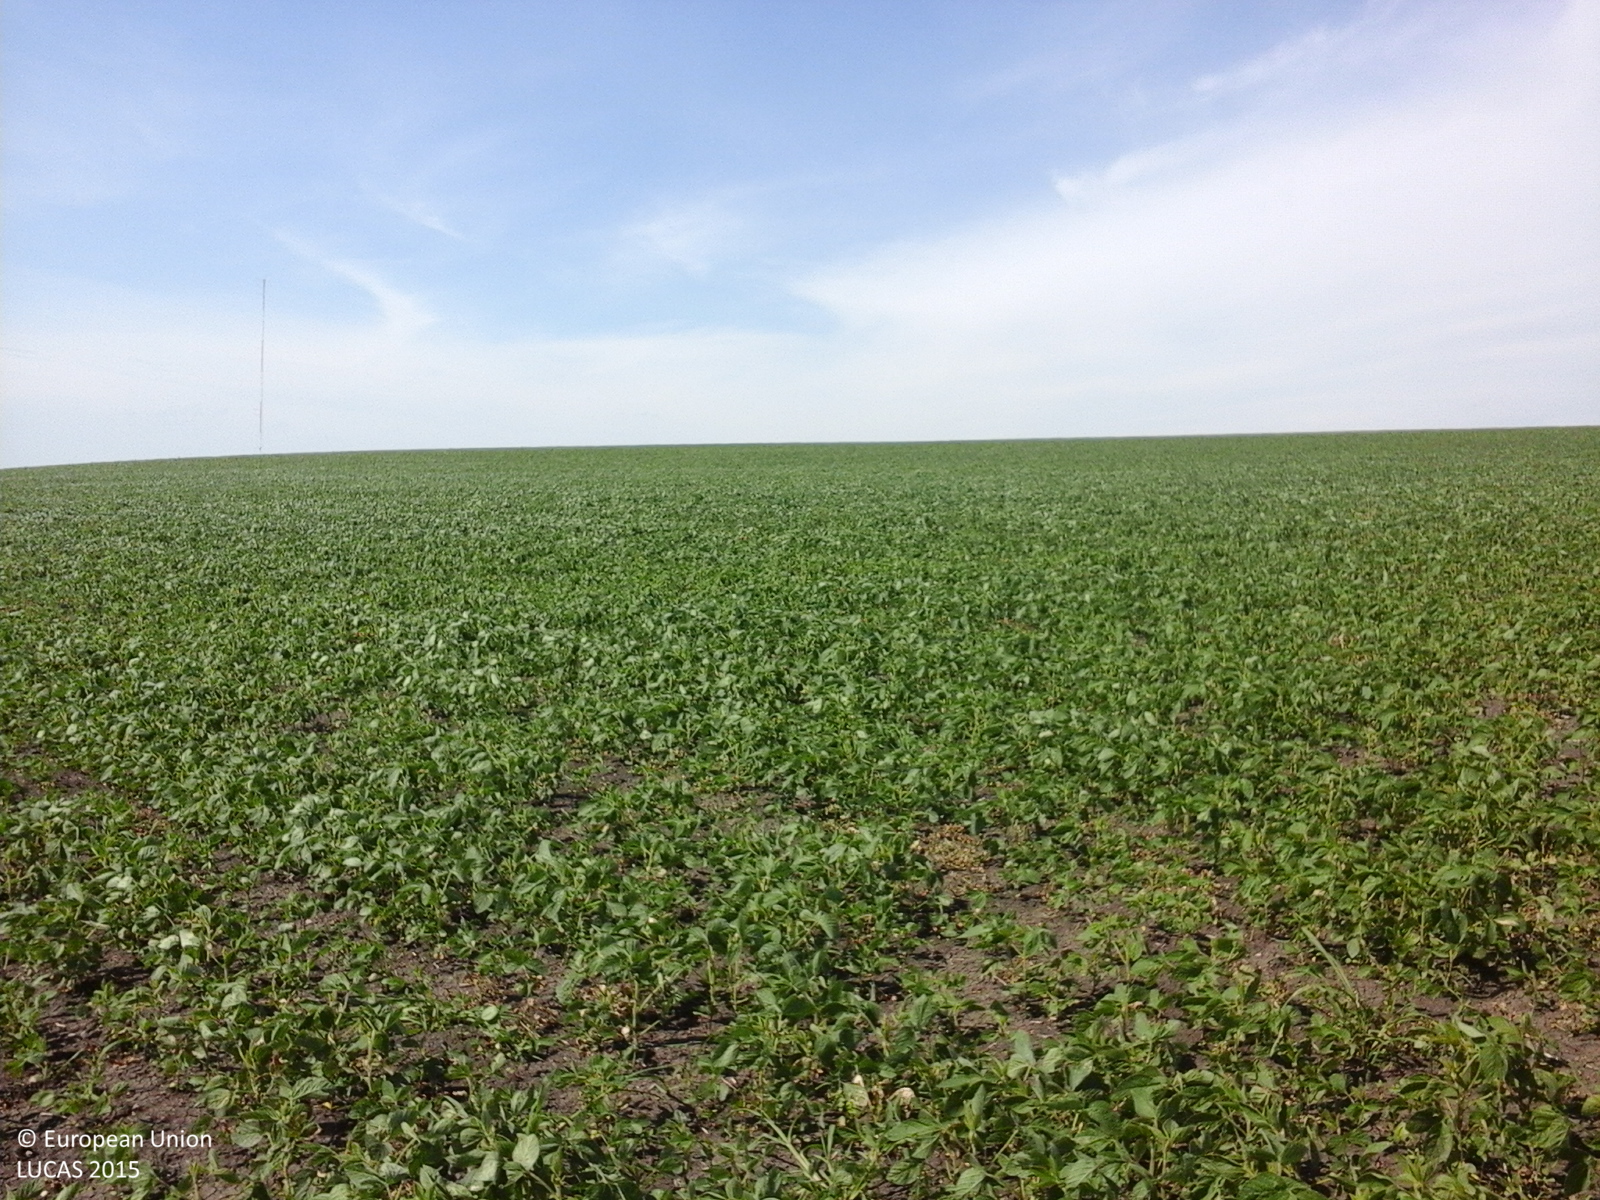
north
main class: Cropland
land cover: Soya
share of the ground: > 75 %
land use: Agriculture (excluding fallow land and kitchen gardens)
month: June
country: RO
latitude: 48.2162
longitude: 26.7489
